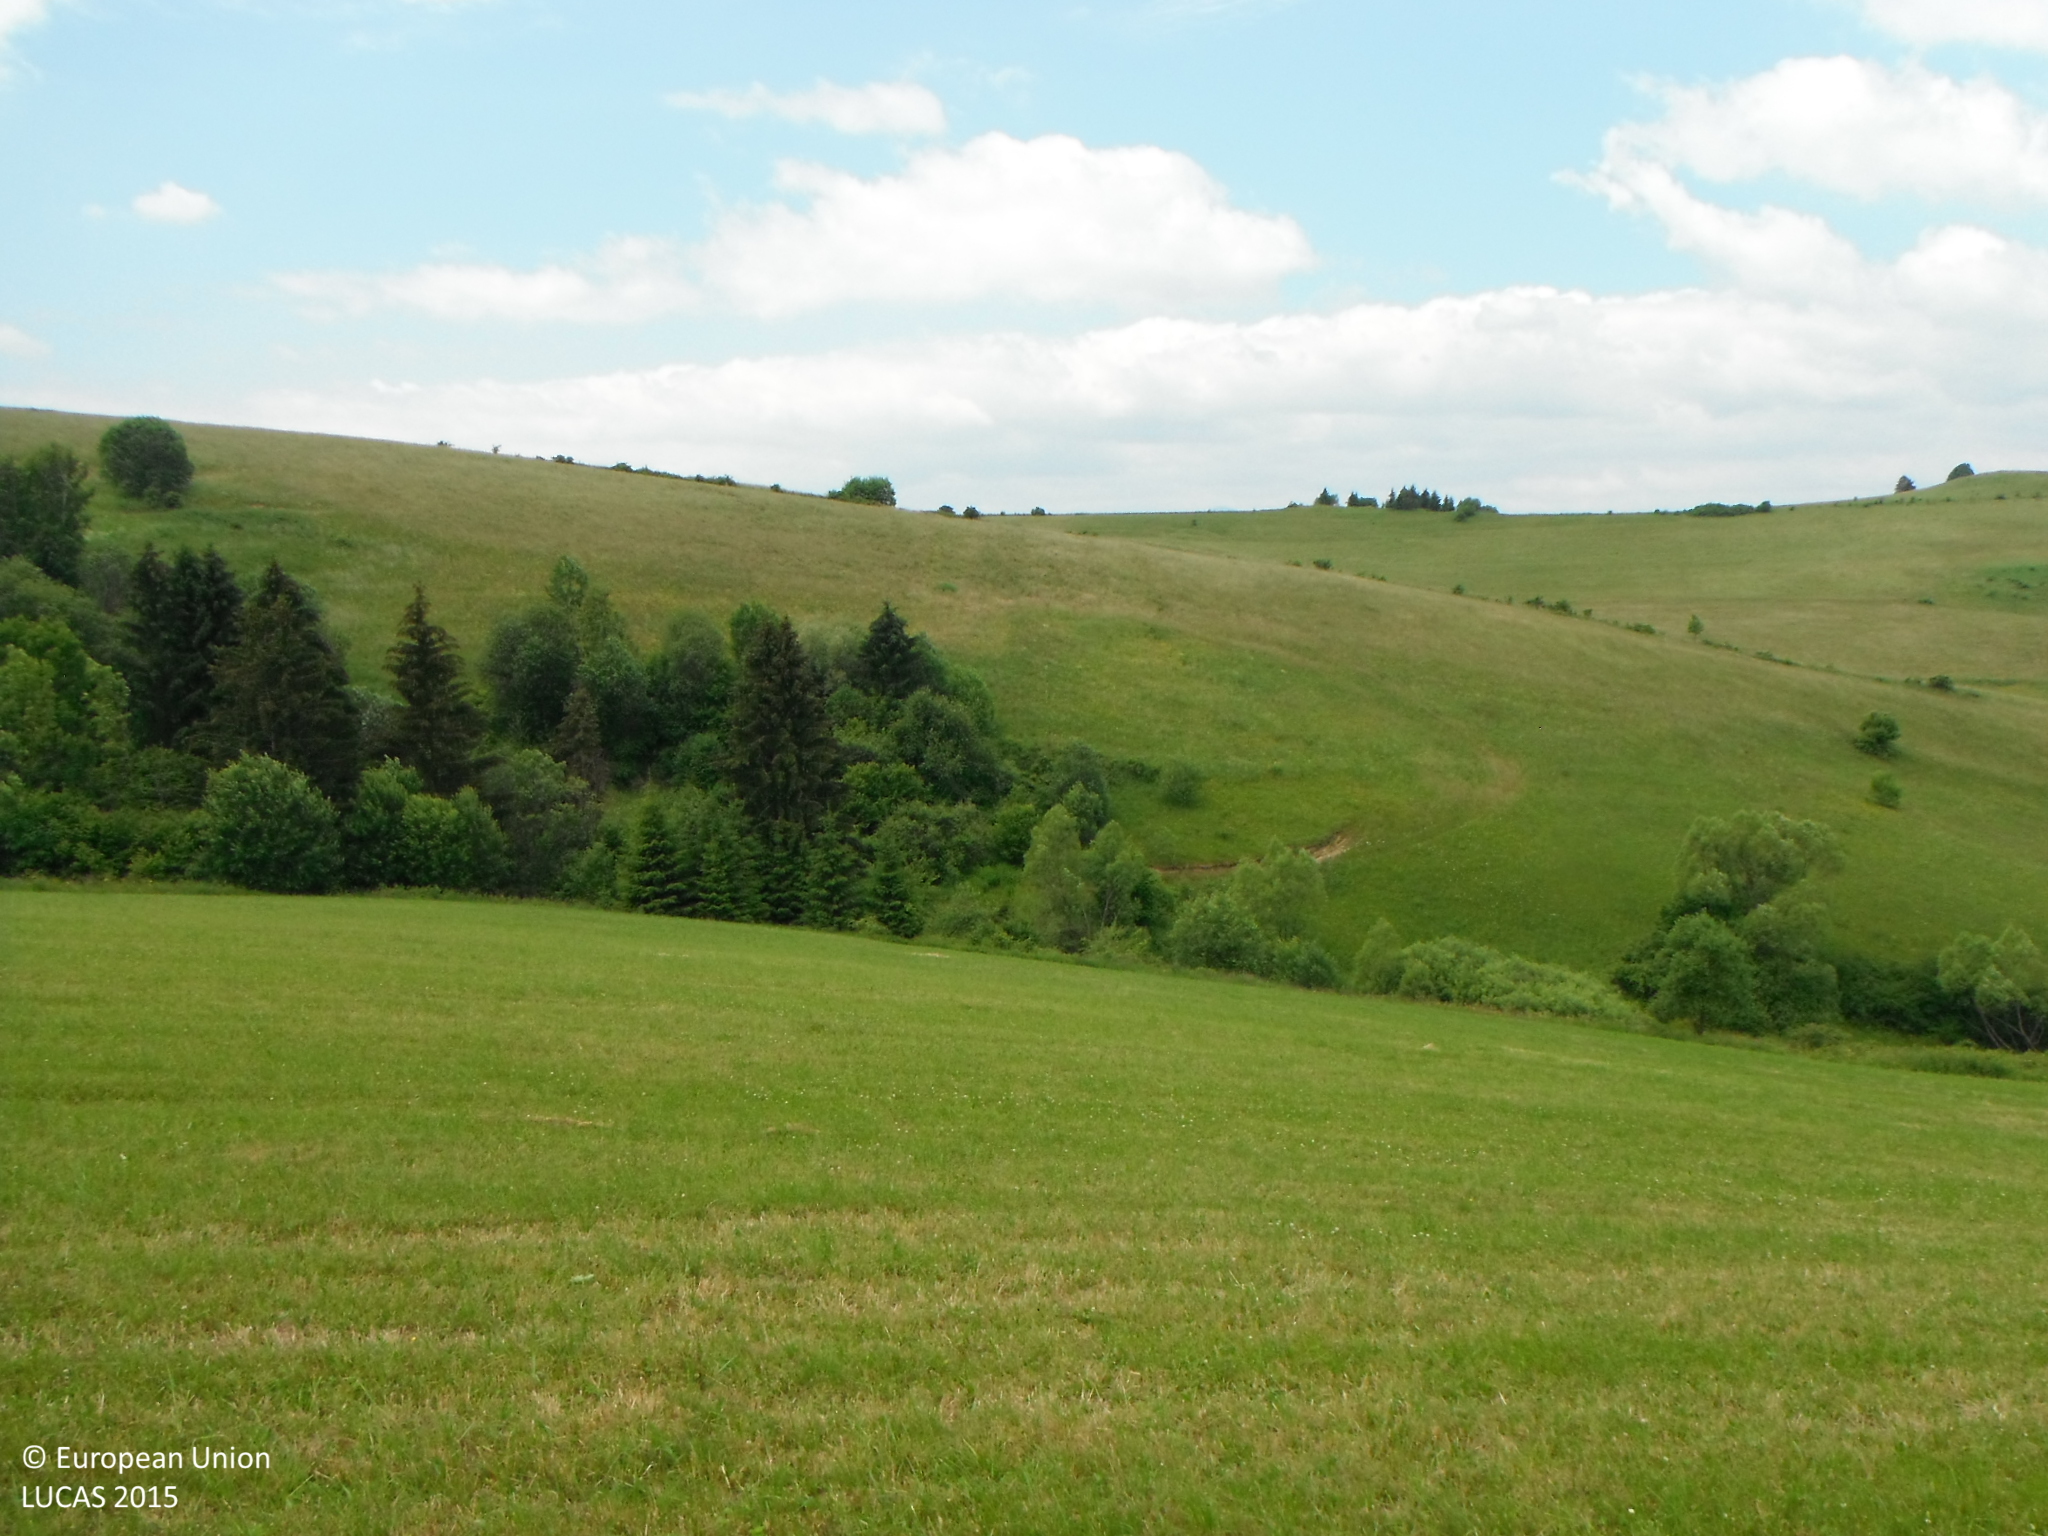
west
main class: Grassland
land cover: Grassland without tree/shrub cover
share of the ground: > 75 %
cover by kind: herbaceous plants 100 %
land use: Agriculture (excluding fallow land and kitchen gardens)
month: June
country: SK
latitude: 49.1954
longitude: 19.4257
